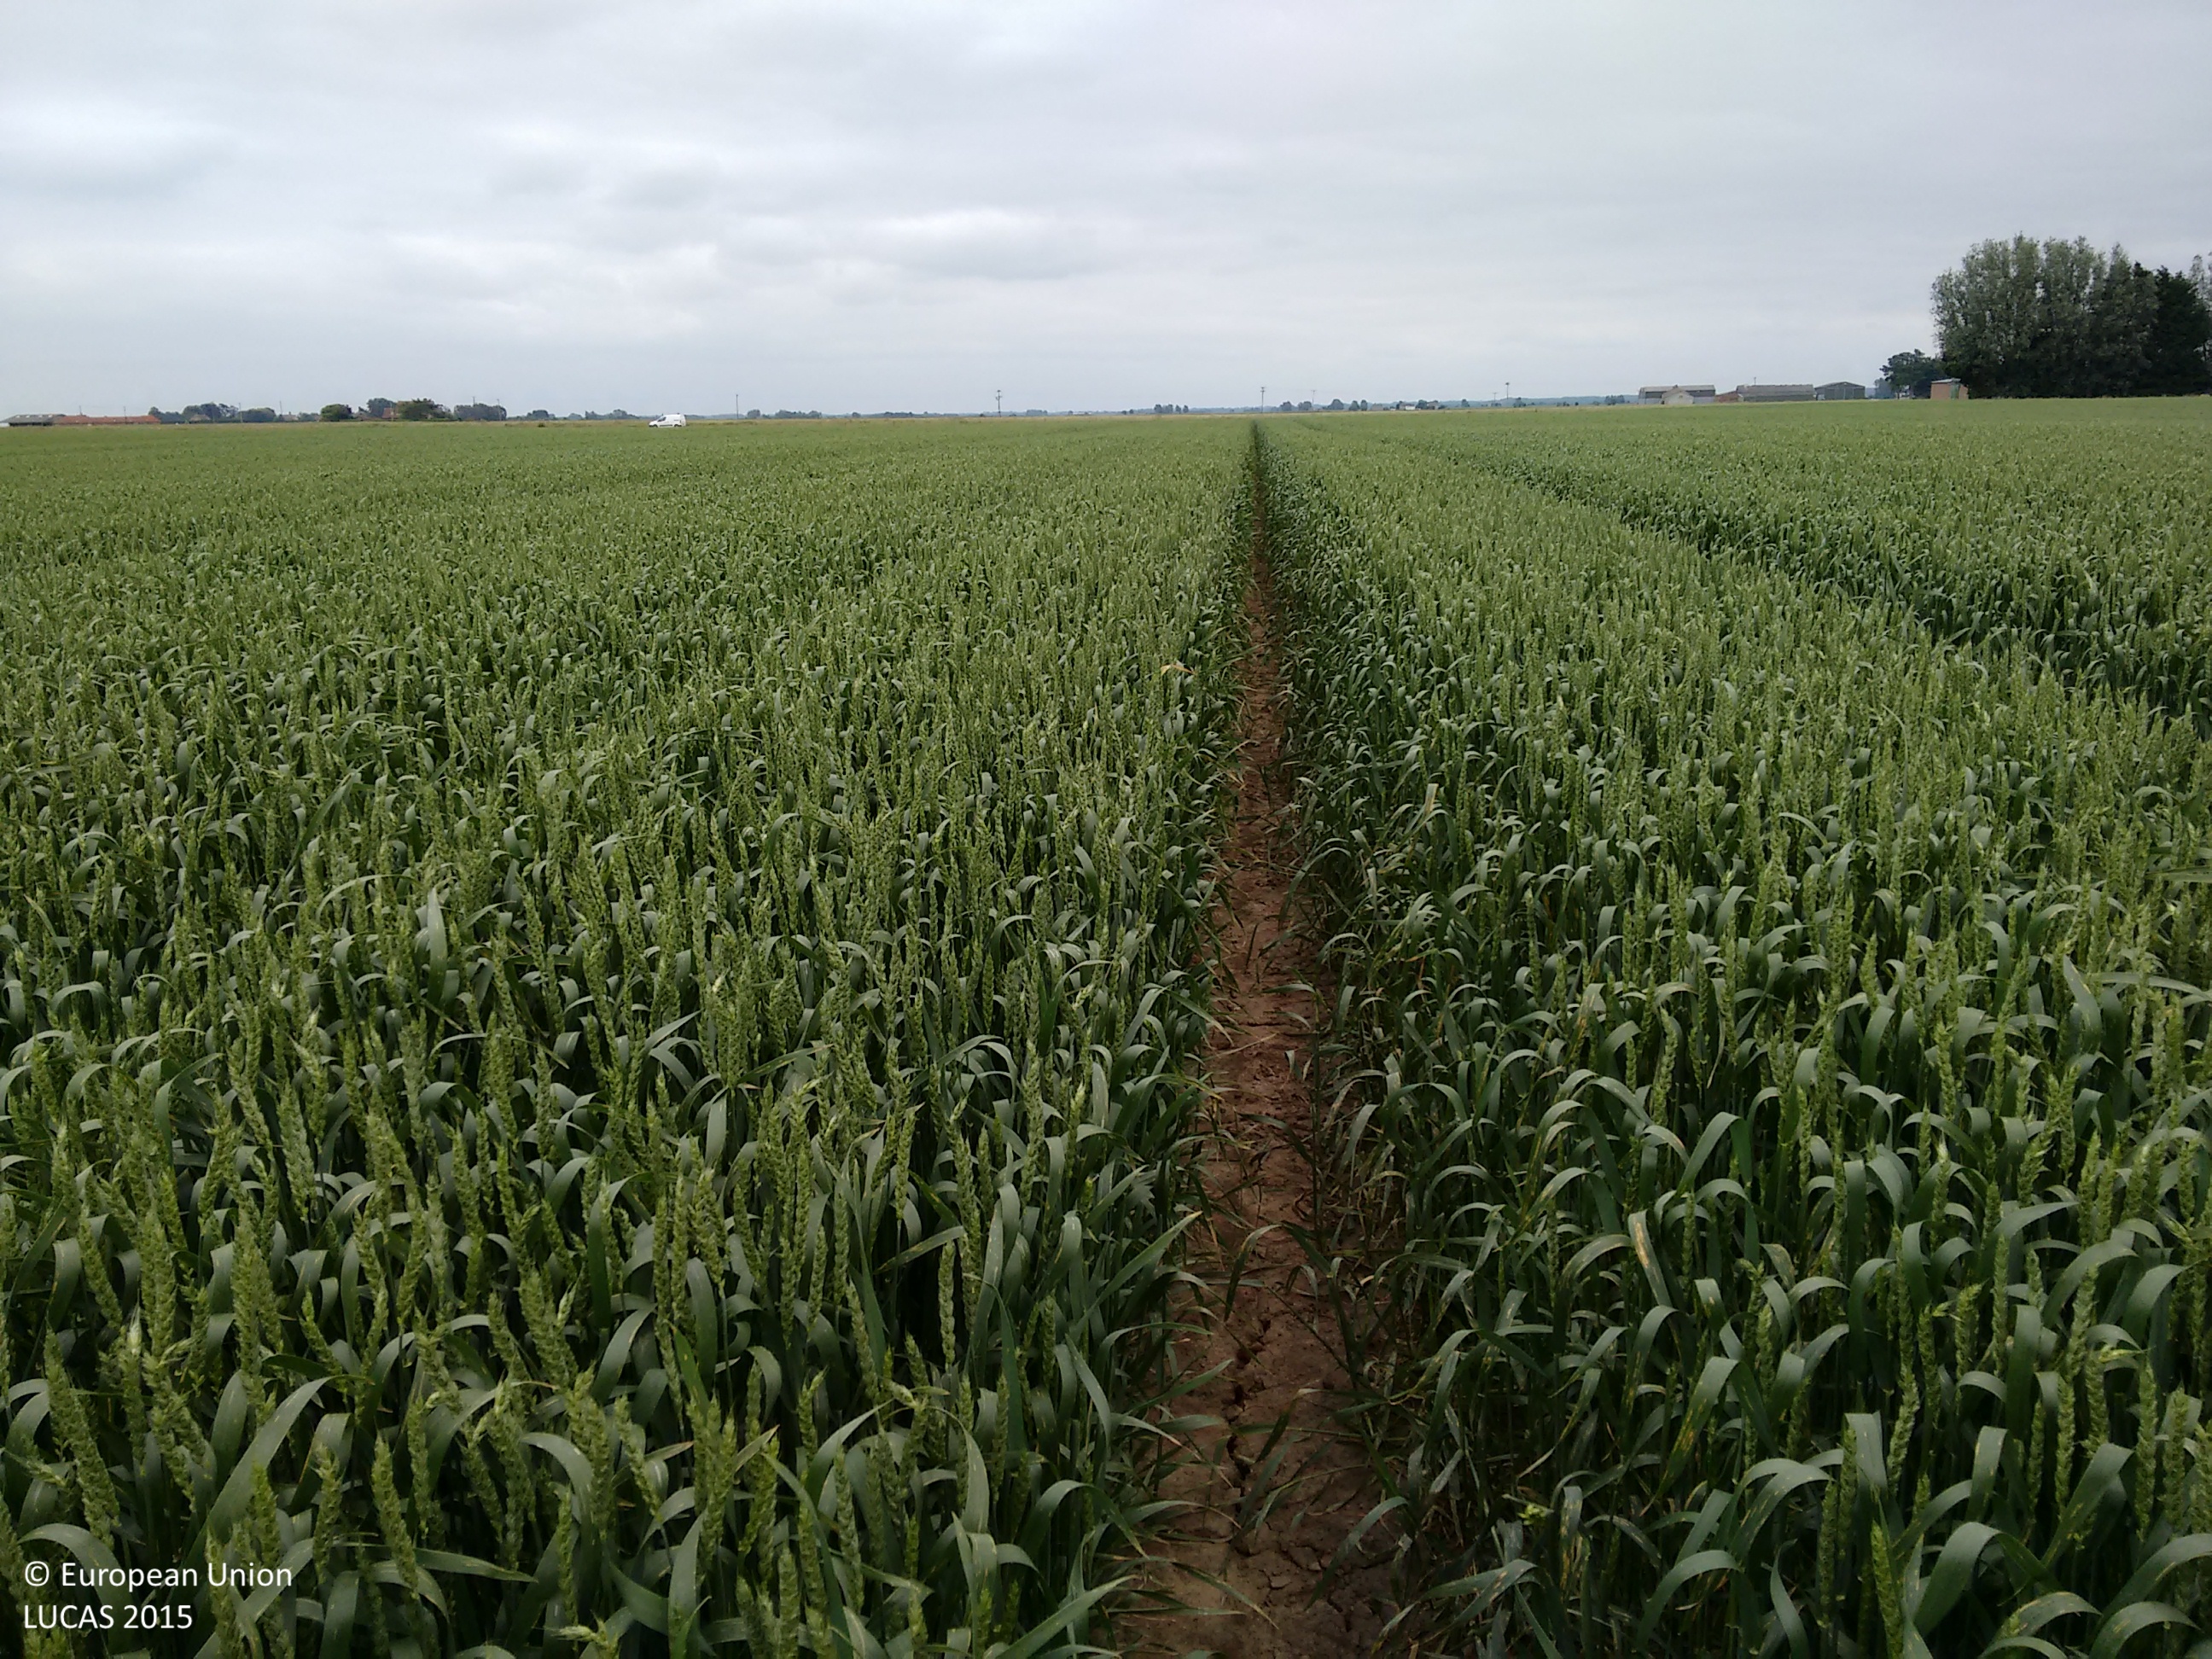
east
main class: Cropland
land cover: Common wheat
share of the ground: > 75 %
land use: Agriculture (excluding fallow land and kitchen gardens)
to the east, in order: Common wheat; Grass margins; Ditches and canals; Grass margins; Paved roads, cycling and walking lanes; Grass margins; Ditches and canals; Grass margins; Barley
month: June
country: GB
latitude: 52.6462
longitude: 0.2598
